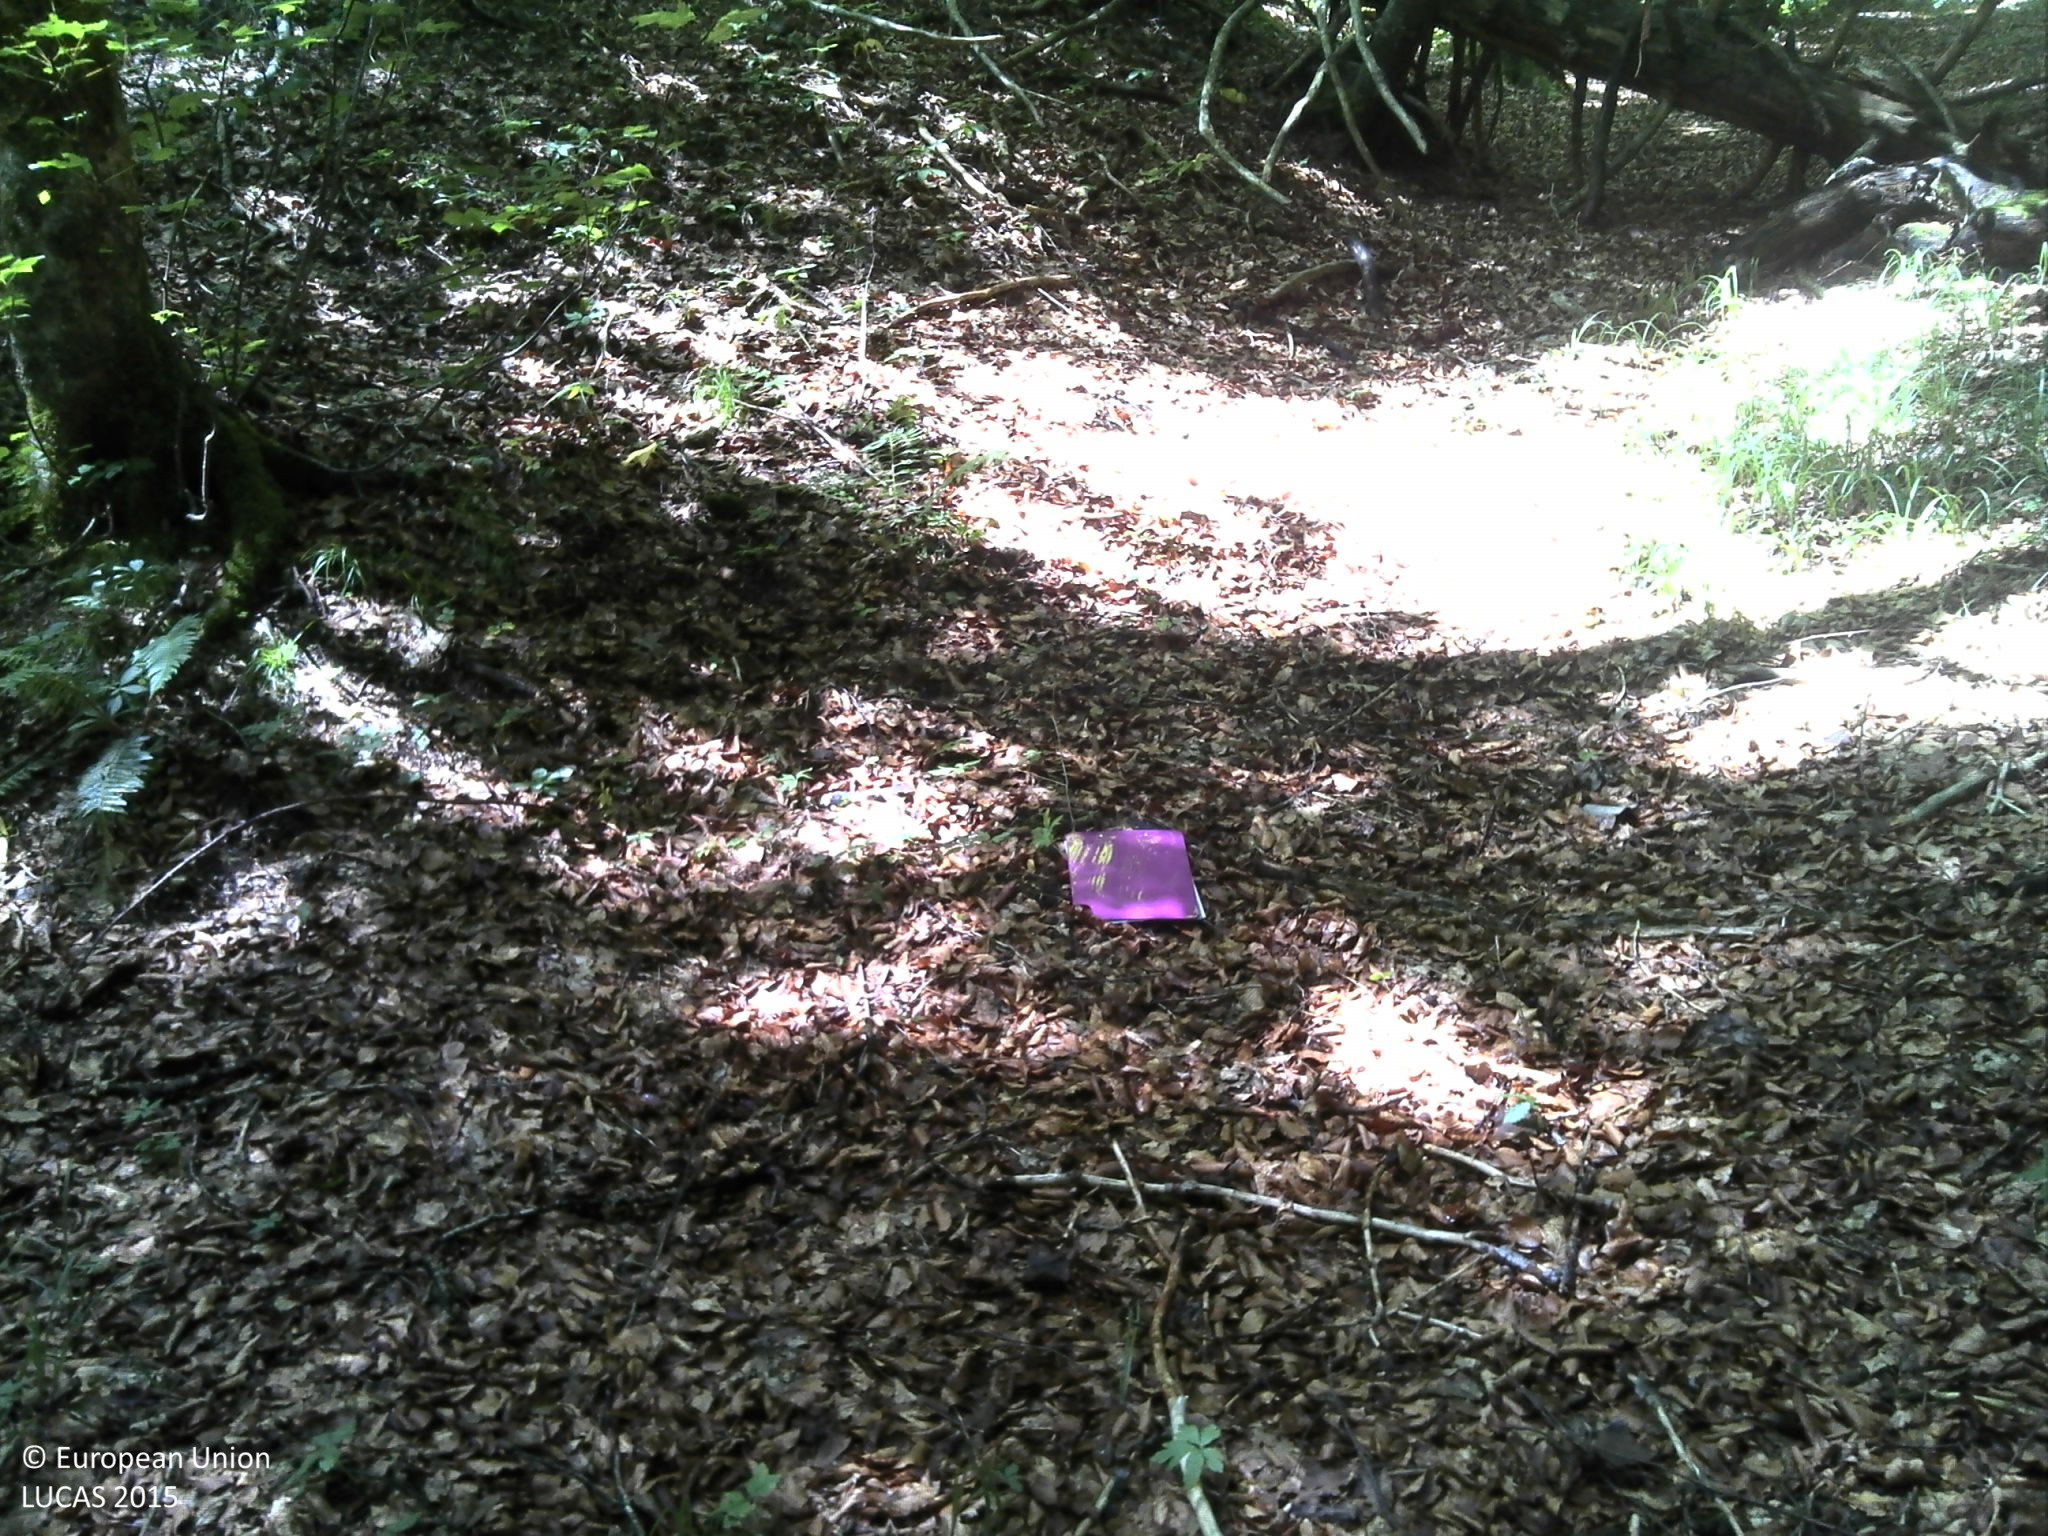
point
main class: Woodland
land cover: Broadleaved woodland
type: beech forest
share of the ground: > 75 %
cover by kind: broadleaved forest trees 95 %, consolidated bare surface 5 %
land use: Semi-natural and natural areas not in use
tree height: > 5 m
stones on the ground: < 10 %
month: June
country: HR
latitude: 44.8486
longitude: 15.6249
